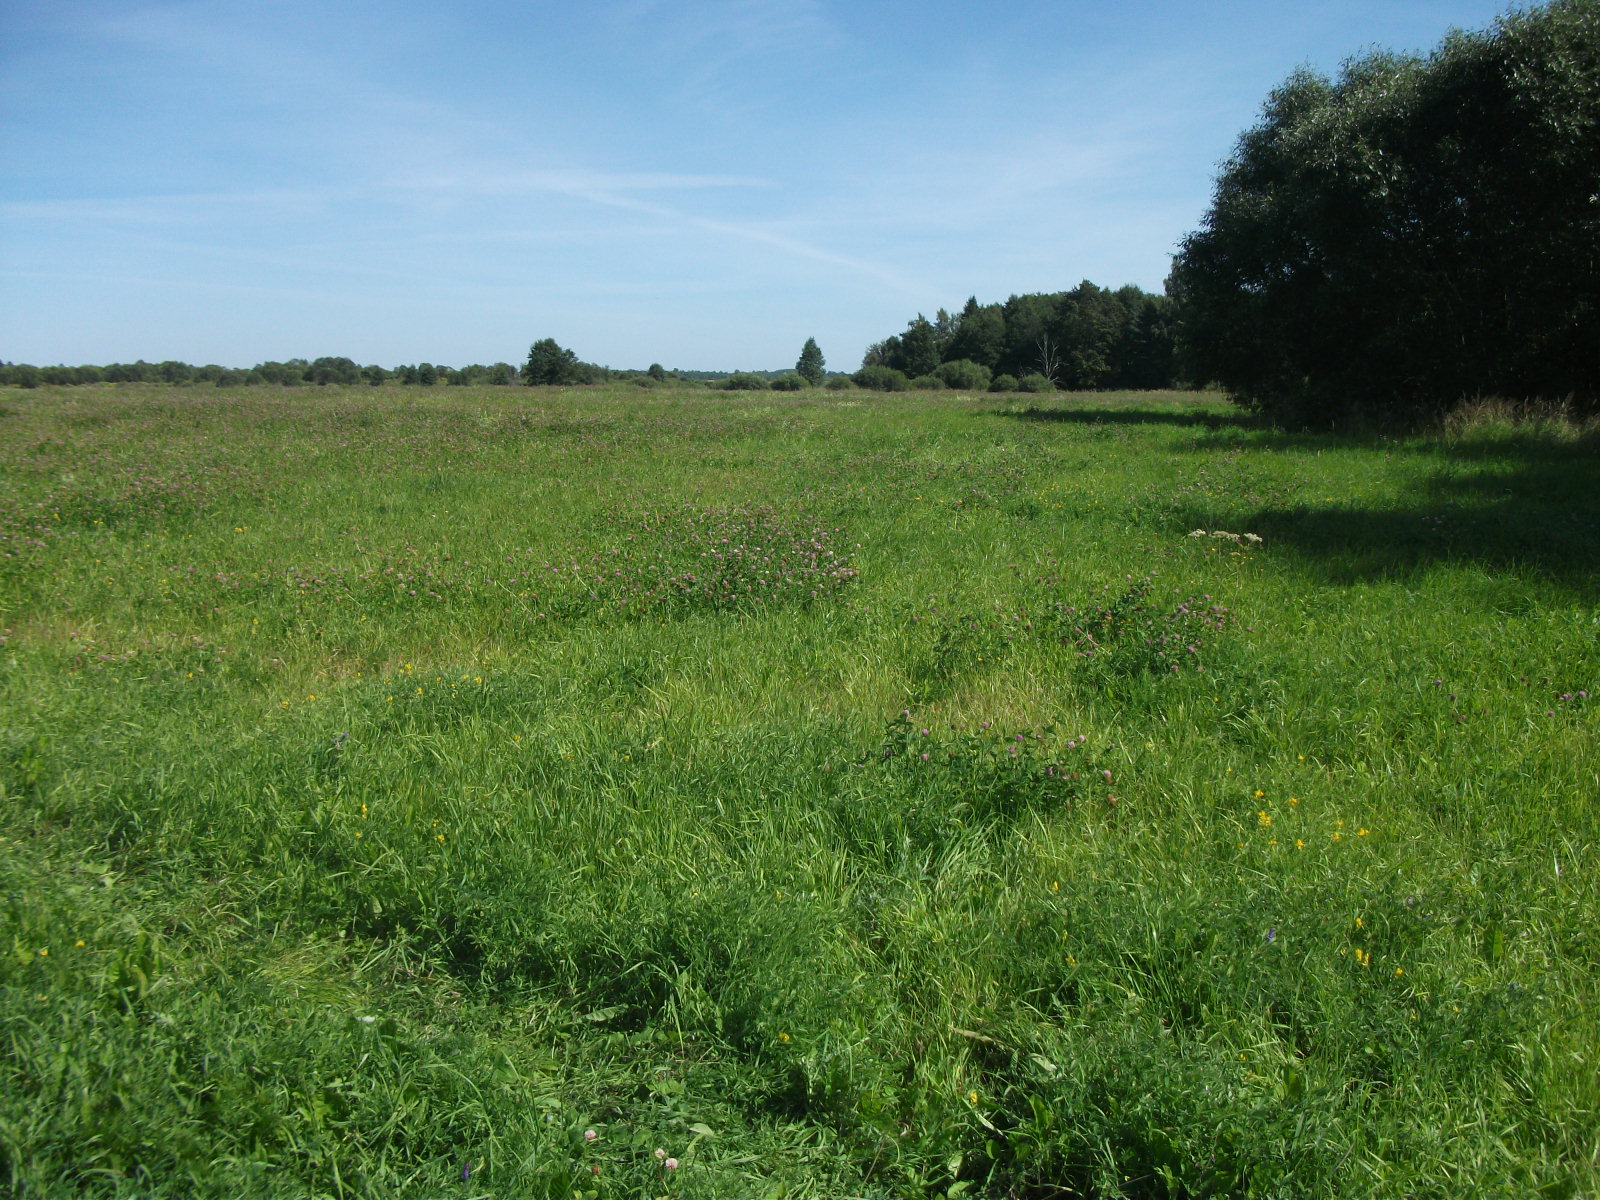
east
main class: Grassland
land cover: Grassland without tree/shrub cover
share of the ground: > 75 %
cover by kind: herbaceous plants 100 %
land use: Agriculture (excluding fallow land and kitchen gardens)
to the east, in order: Grassland without tree/shrub cover; Abandoned hedges; Ditches and canals
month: August
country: LV
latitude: 56.2270
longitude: 26.3883
